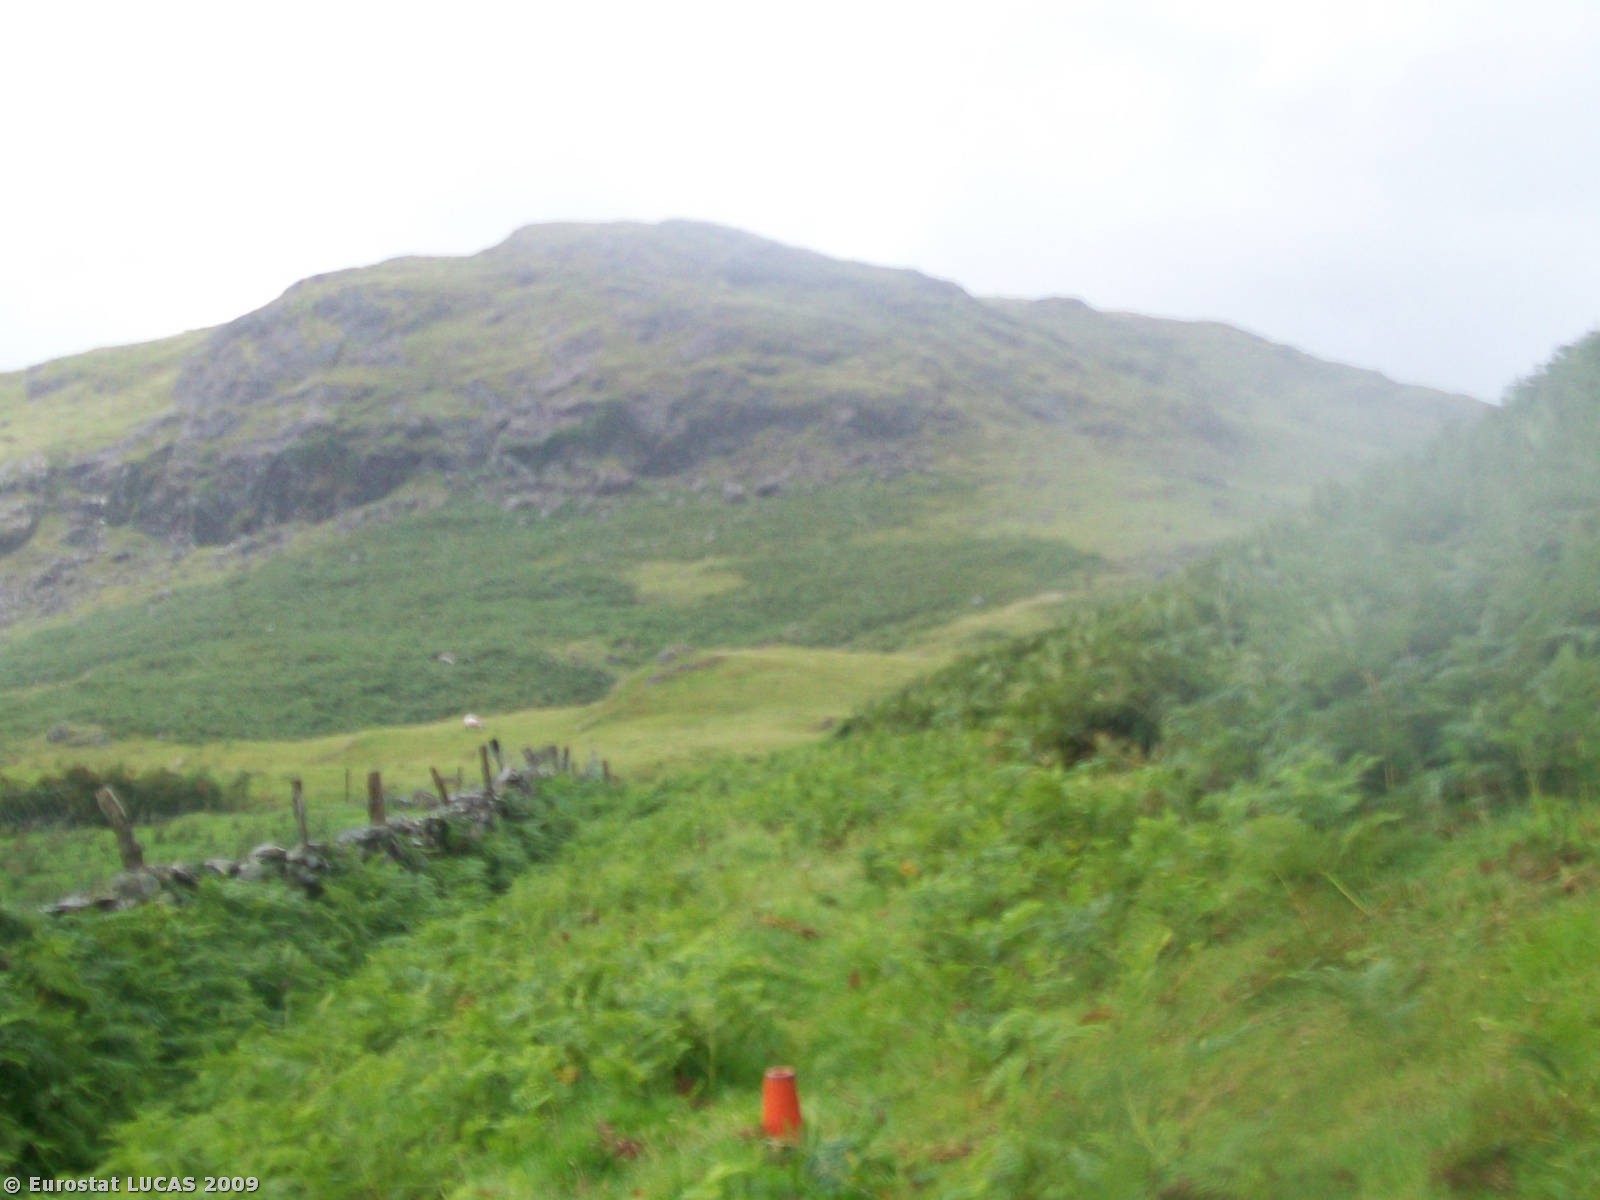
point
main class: Grassland
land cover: Grassland without tree/shrub cover
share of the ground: > 75 %
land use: Agriculture (excluding fallow land and kitchen gardens)
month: July
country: IE
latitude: 53.5749
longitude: -9.4871
